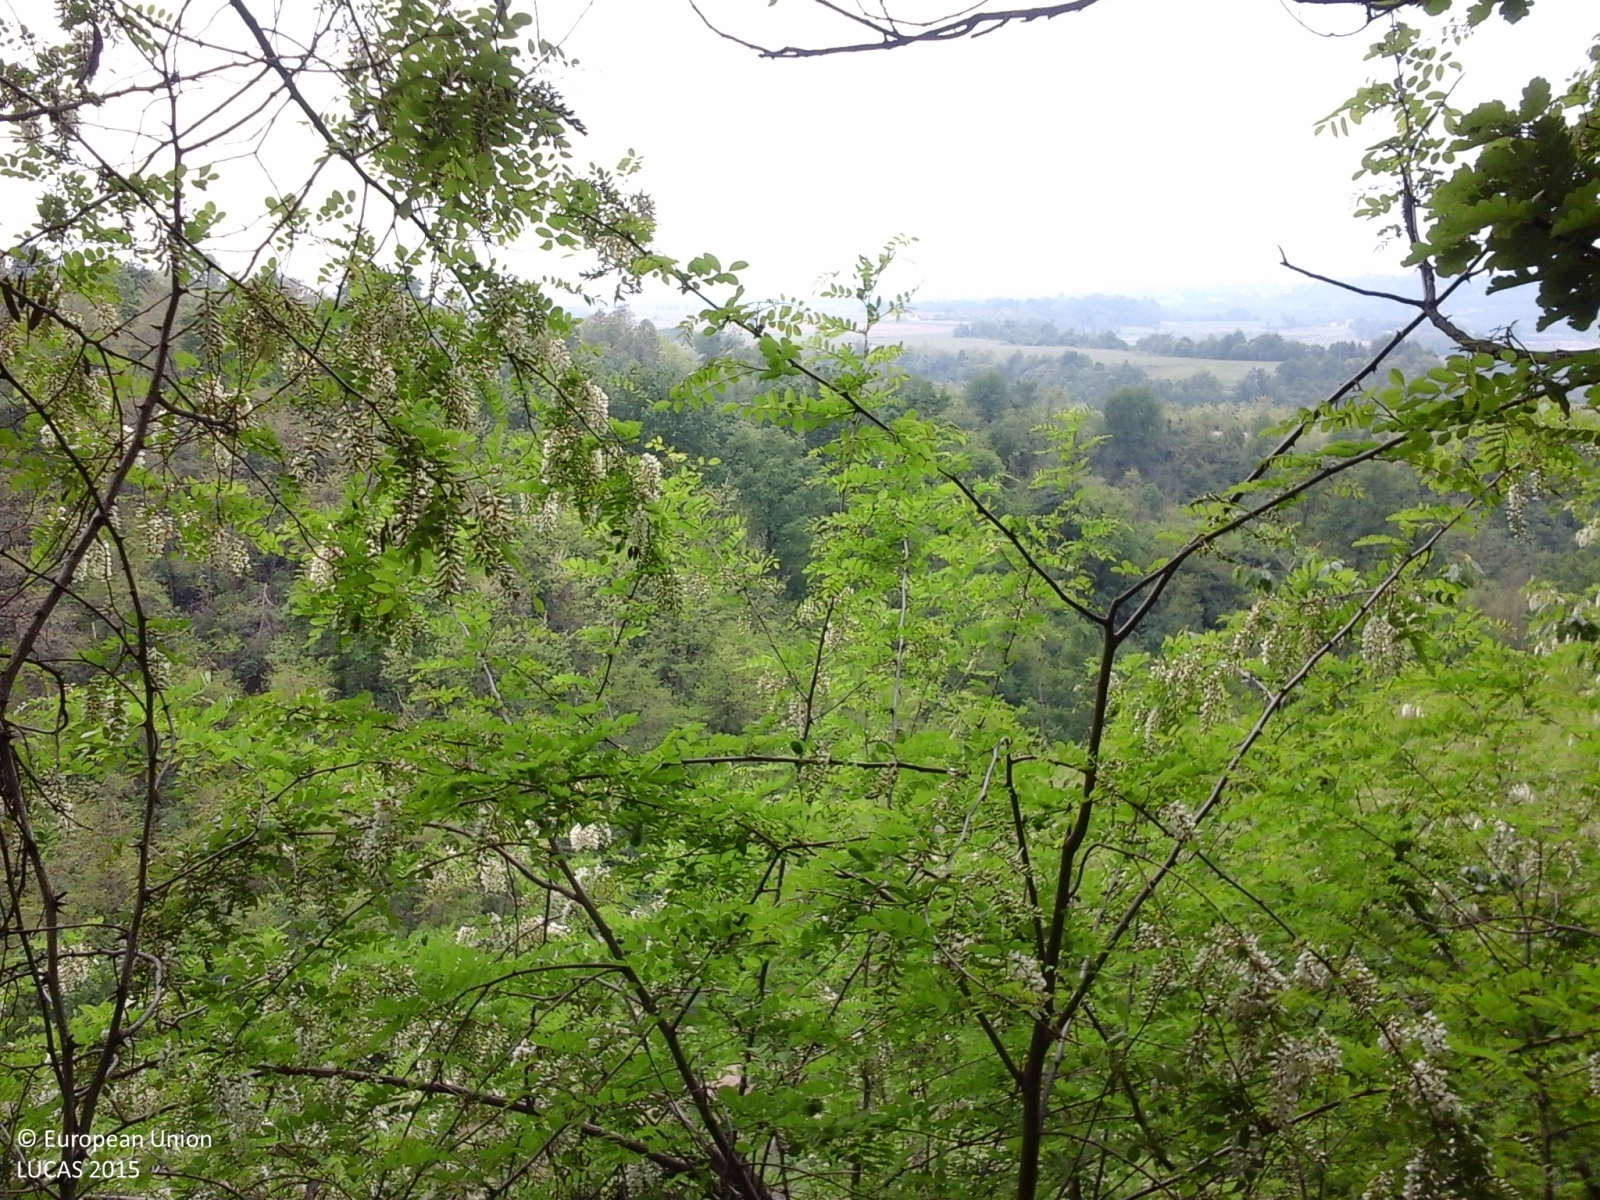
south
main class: Woodland
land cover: Broadleaved woodland
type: thermophilous deciduous forest
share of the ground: > 75 %
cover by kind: broadleaved forest trees 95 %, herbaceous plants 5 %
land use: Forestry
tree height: > 5 m
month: May
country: IT
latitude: 44.5613
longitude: 7.7761
